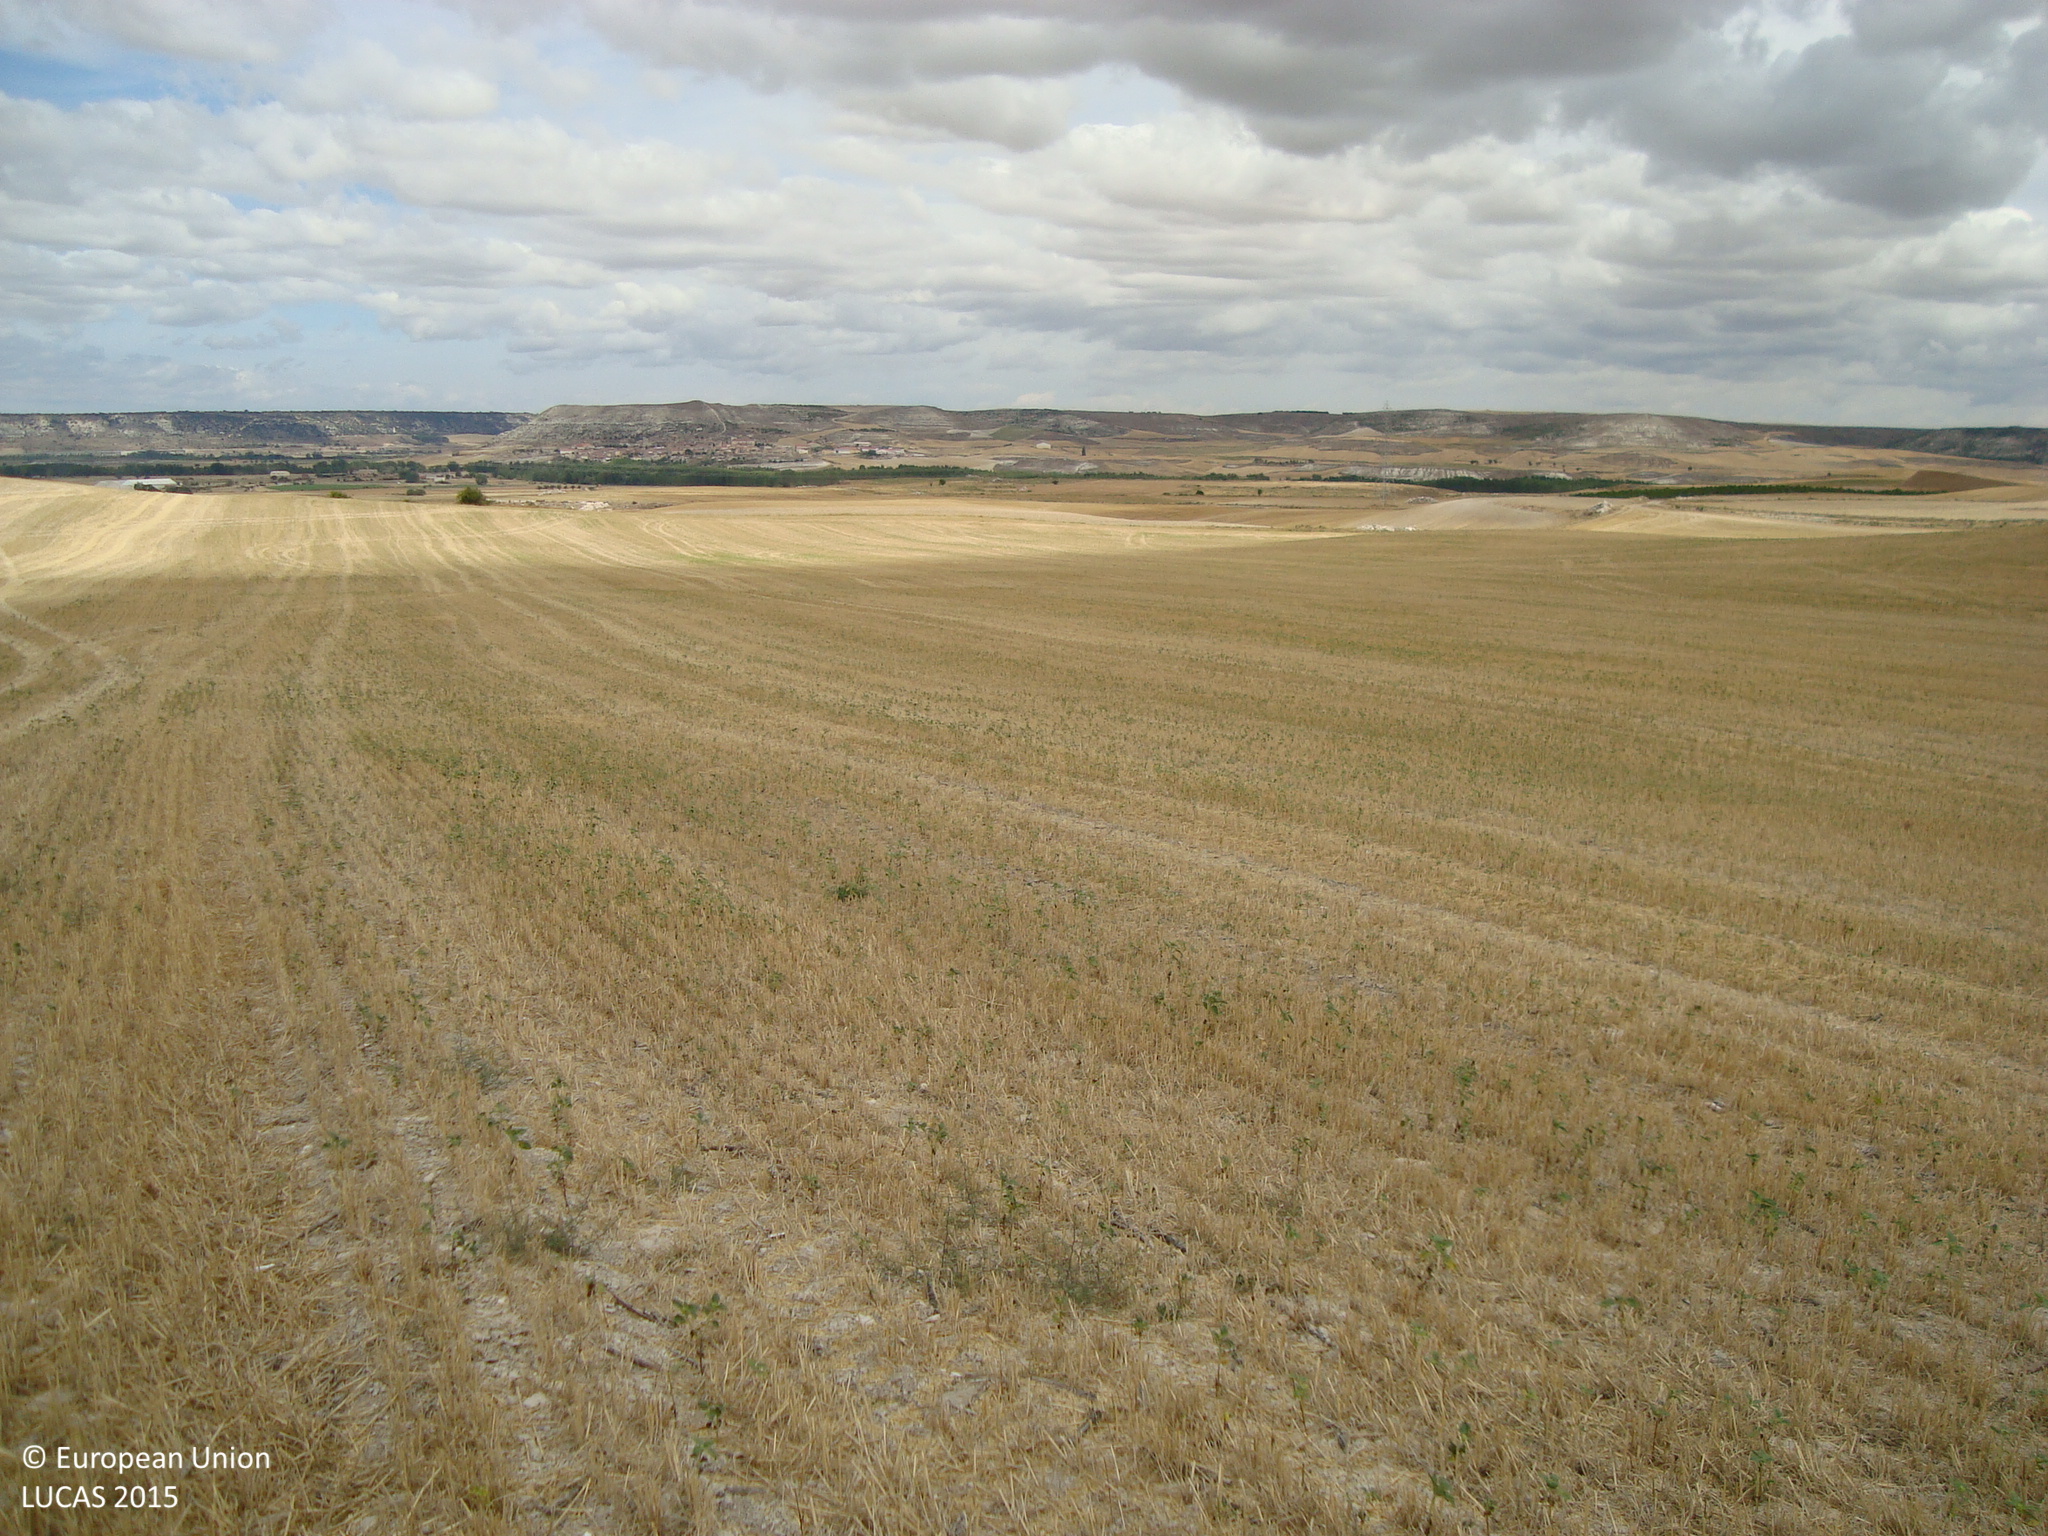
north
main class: Cropland
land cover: Common wheat
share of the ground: > 75 %
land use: Agriculture (excluding fallow land and kitchen gardens)
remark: Harvested field
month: August
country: ES
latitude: 42.0622
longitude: -4.1183
